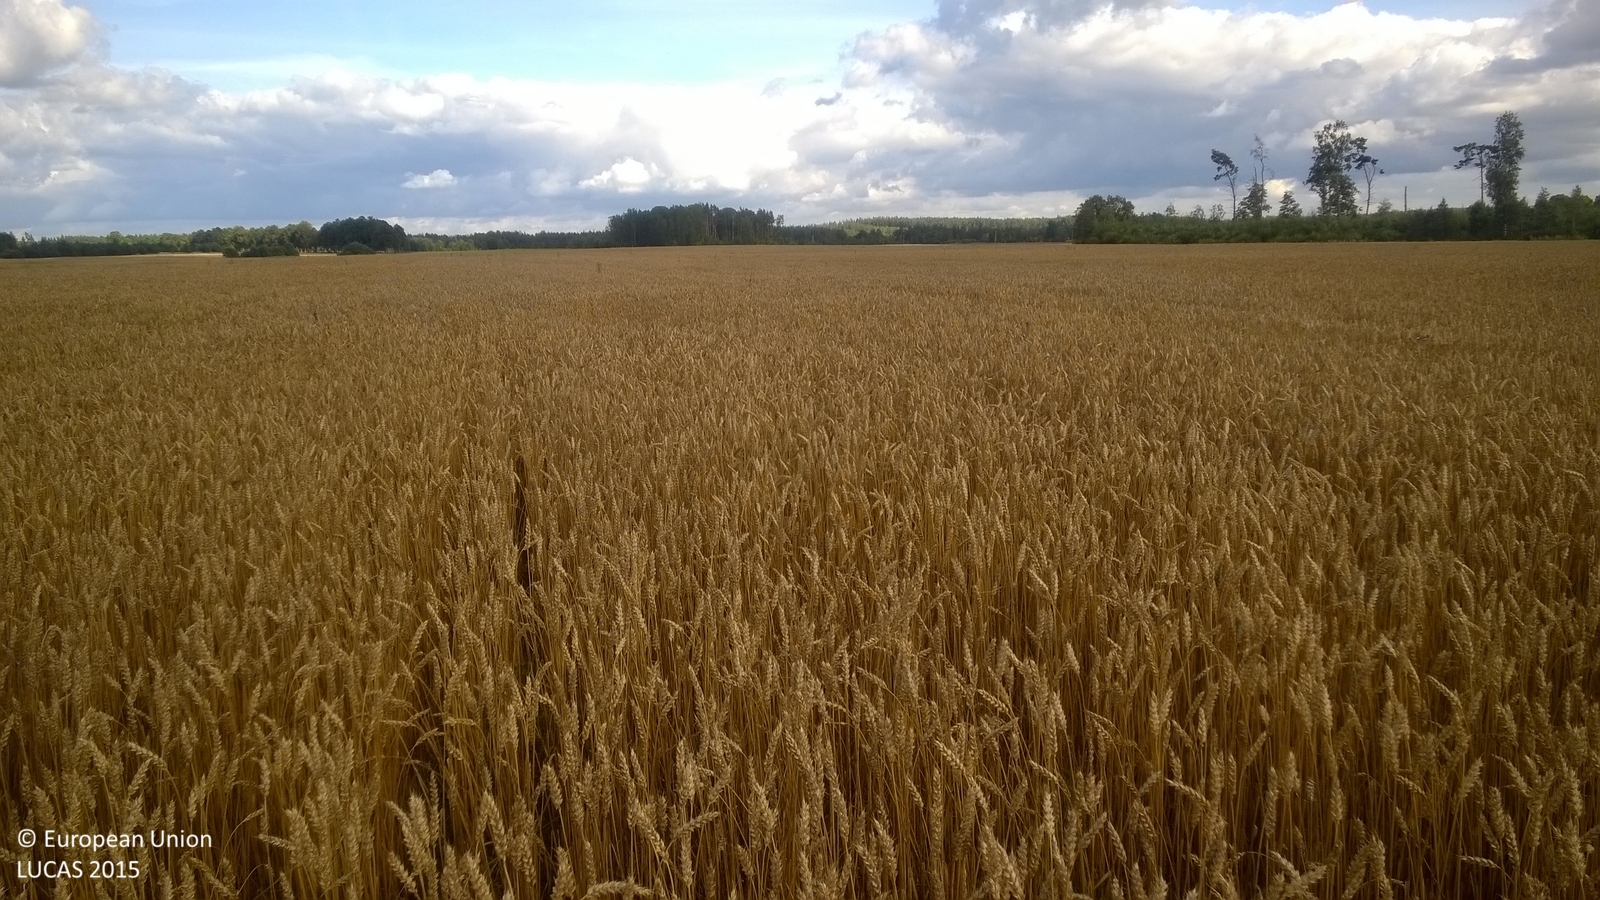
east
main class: Cropland
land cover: Common wheat
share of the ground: > 75 %
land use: Agriculture (excluding fallow land and kitchen gardens)
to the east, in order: Common wheat
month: August
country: LV
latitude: 57.3904
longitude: 25.9155
